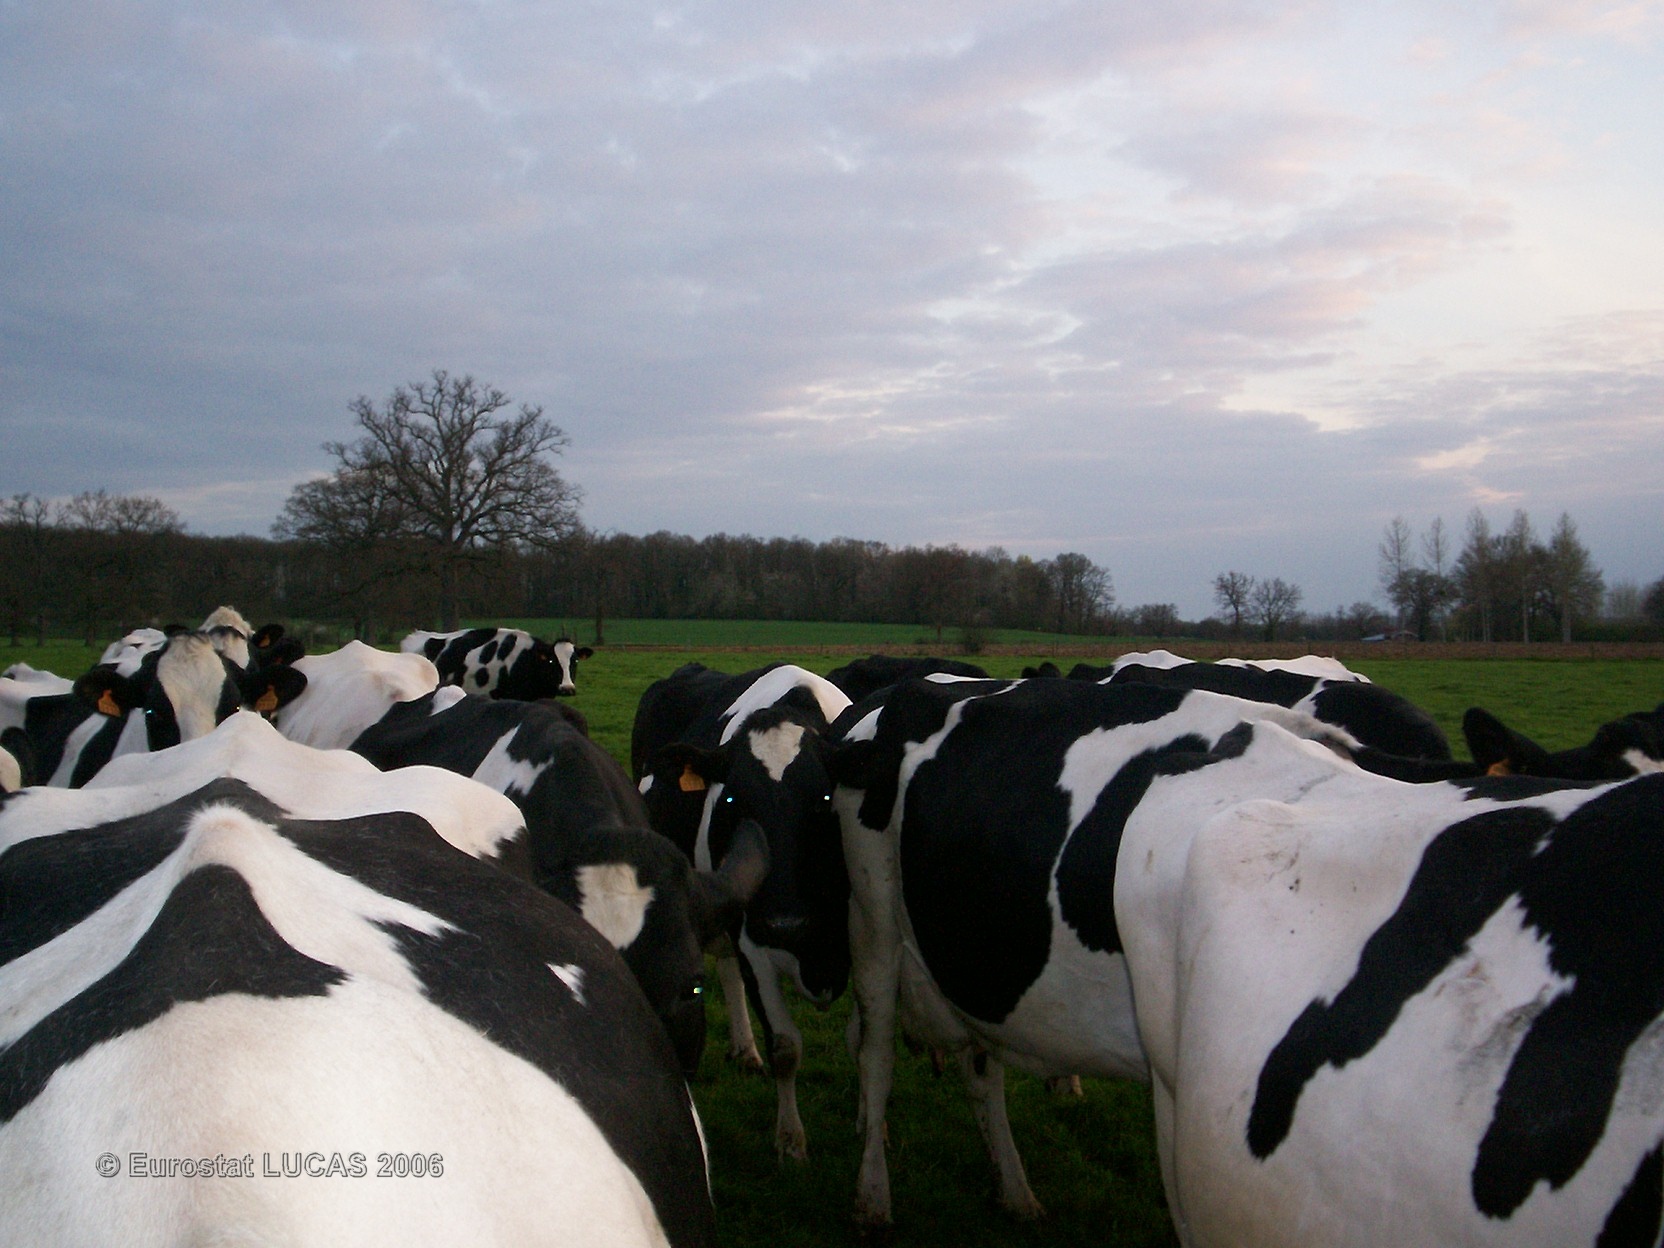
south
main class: Grassland
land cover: Grassland without tree/shrub cover
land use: Agriculture (excluding fallow land and kitchen gardens)
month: April
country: FR
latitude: 48.3041
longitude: 0.1169
